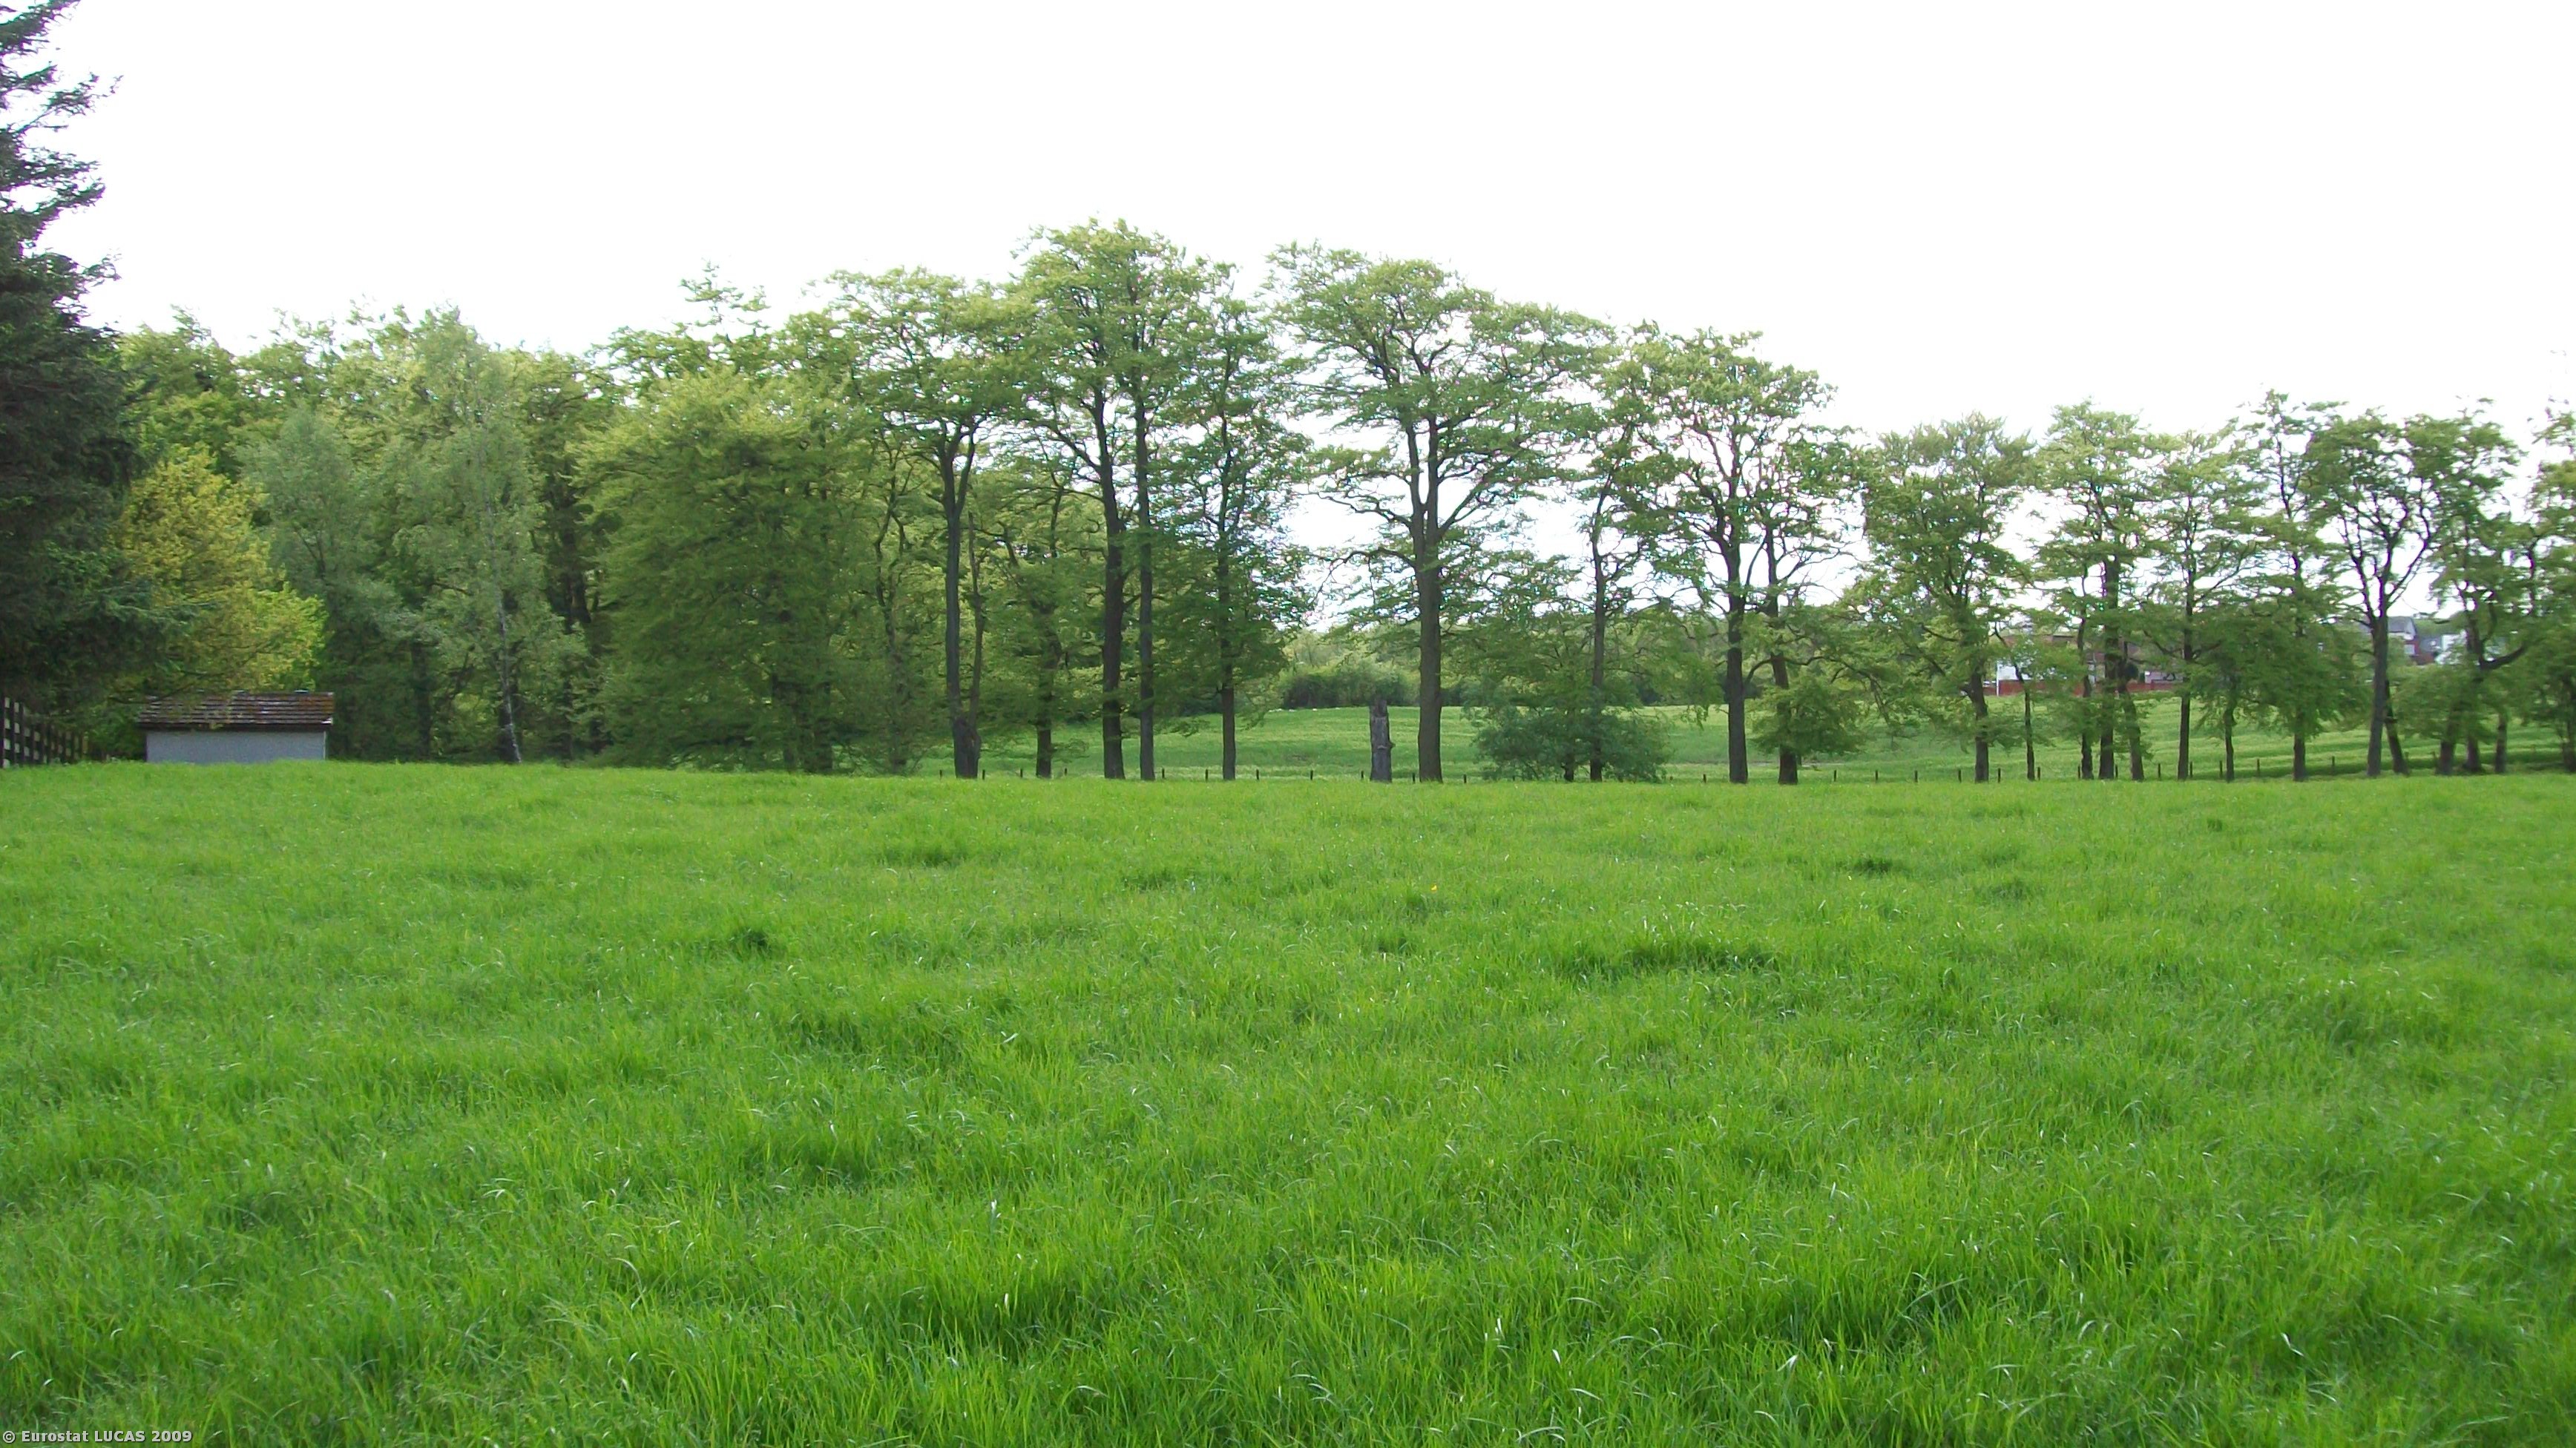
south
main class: Grassland
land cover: Grassland without tree/shrub cover
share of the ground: > 75 %
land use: Agriculture (excluding fallow land and kitchen gardens)
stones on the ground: < 10 %
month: May
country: GB
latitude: 55.9232
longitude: -3.6999
